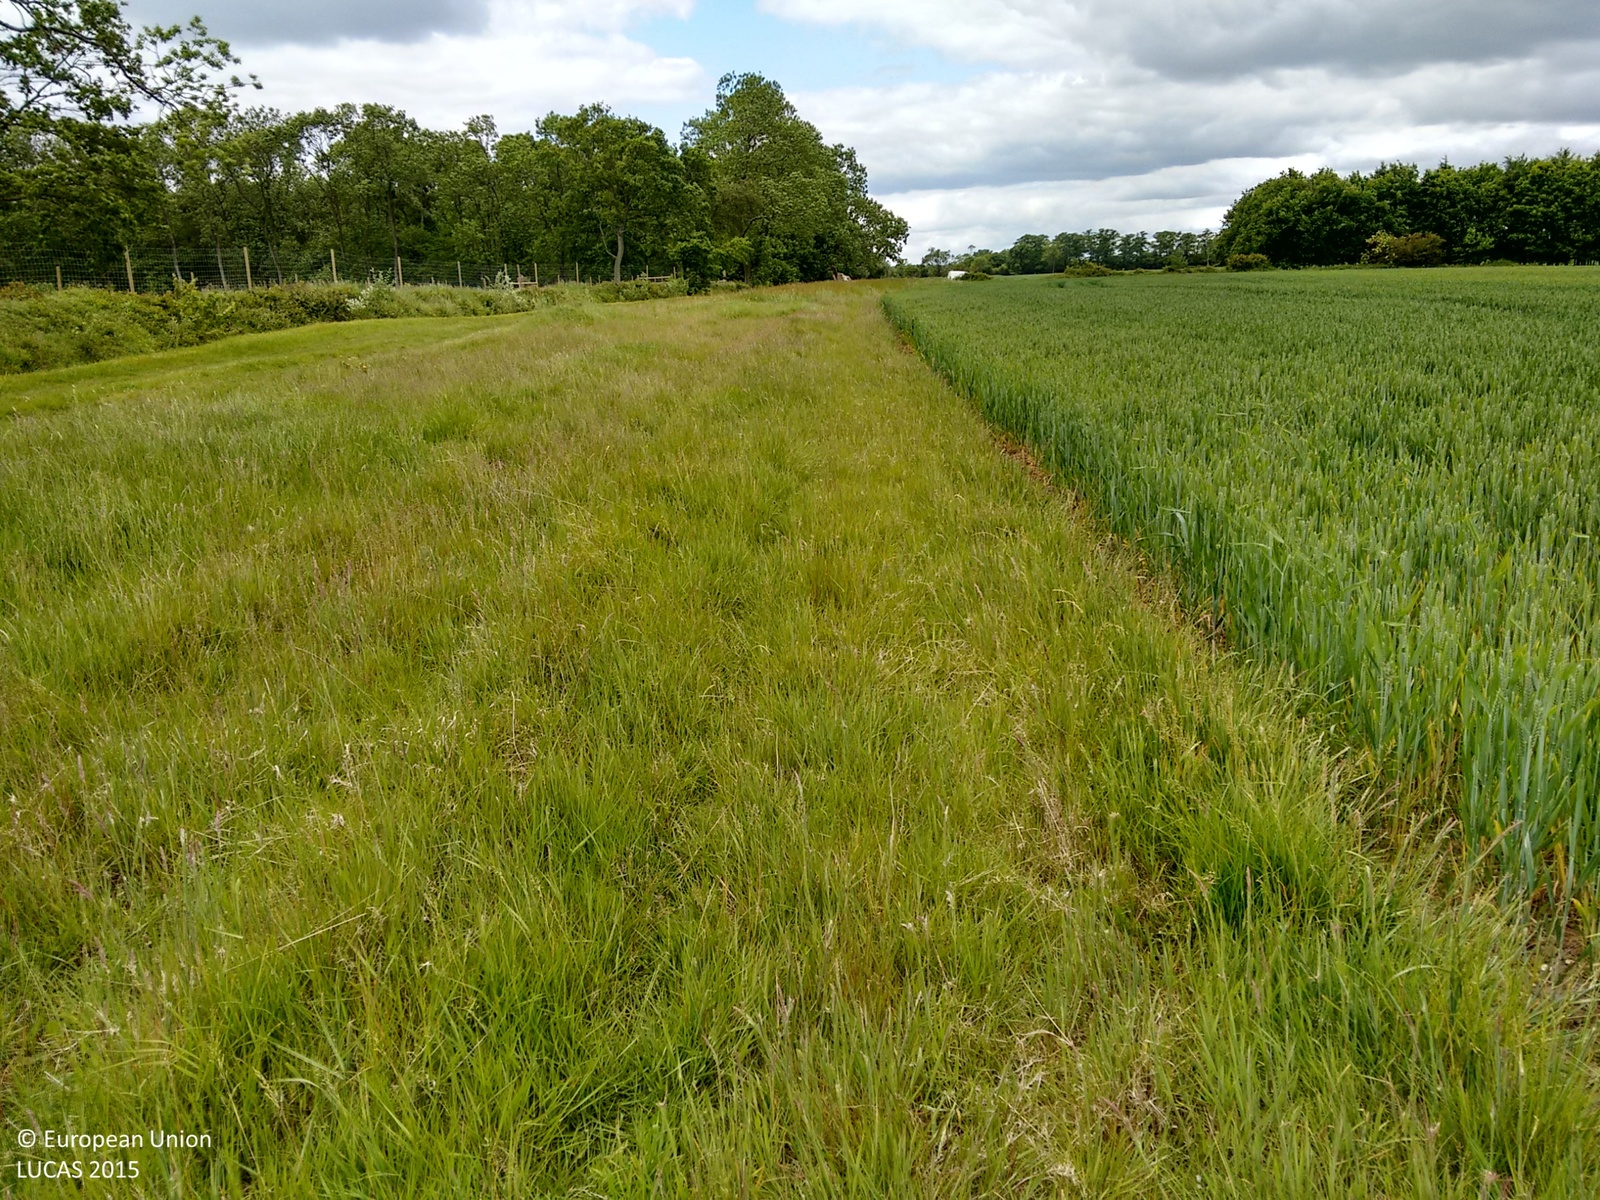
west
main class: Grassland
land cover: Grassland without tree/shrub cover
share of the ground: > 75 %
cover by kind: herbaceous plants 100 %
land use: Agriculture (excluding fallow land and kitchen gardens)
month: June
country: GB
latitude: 52.8199
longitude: -0.4692
